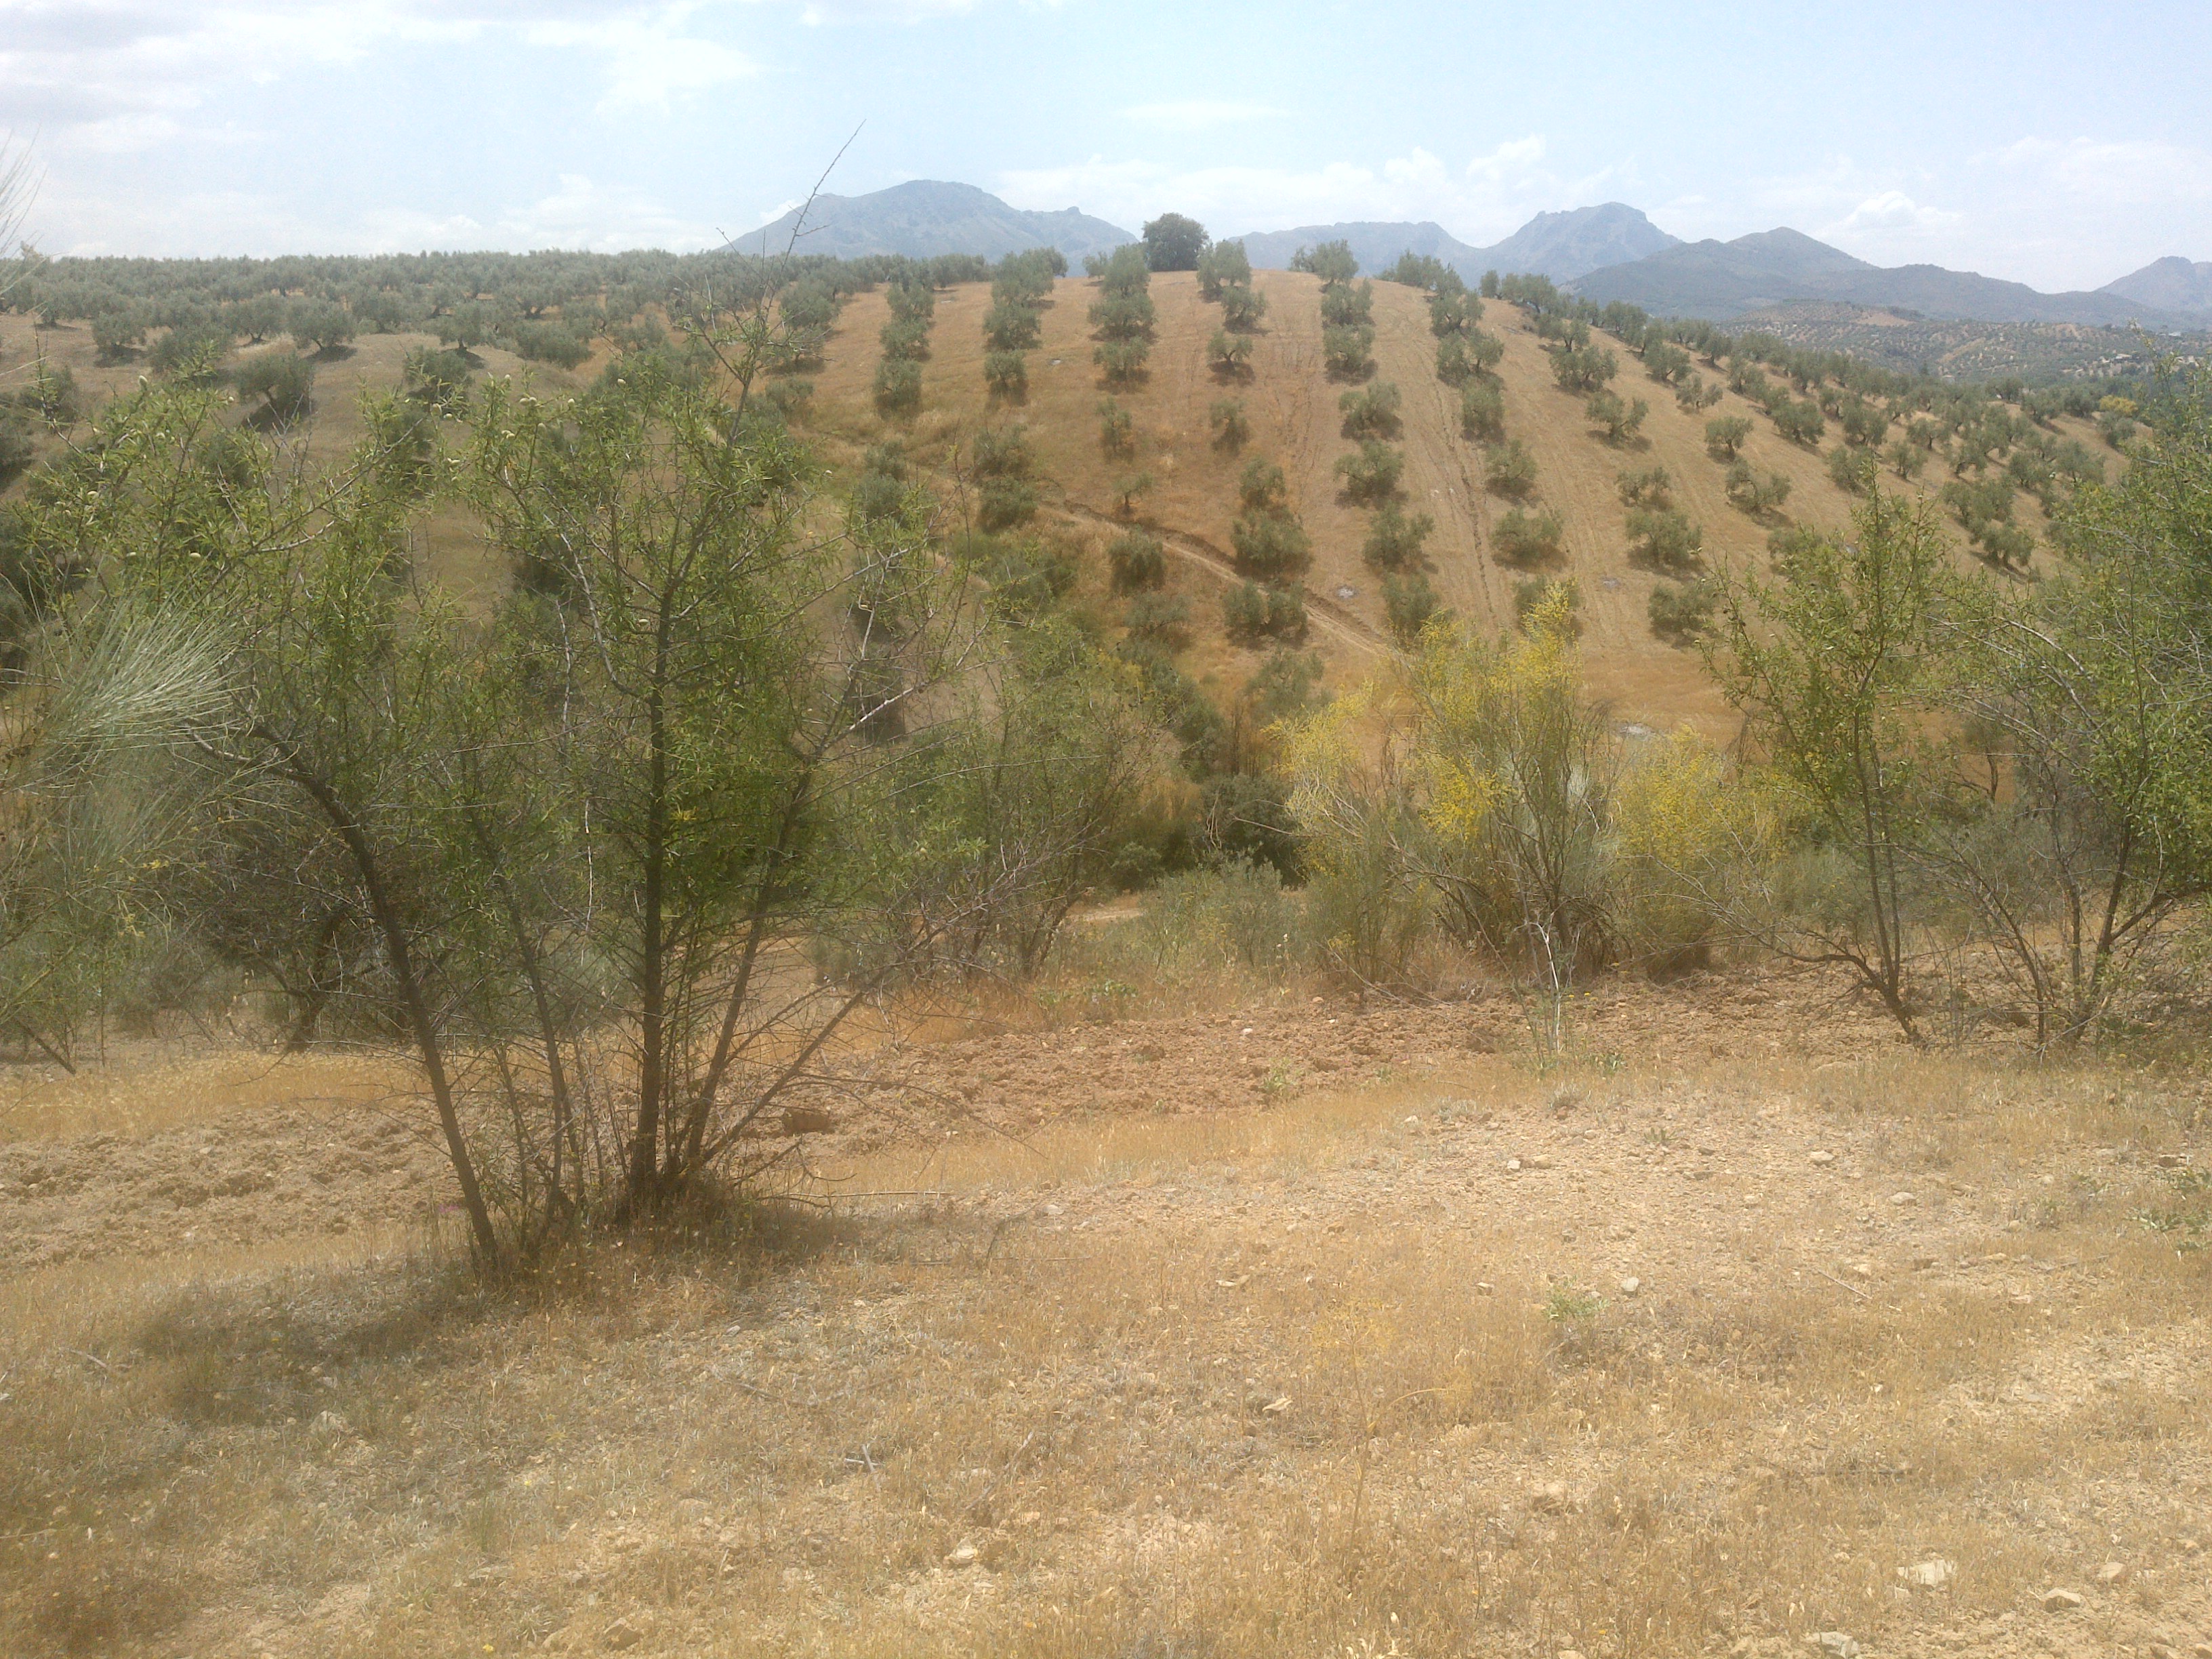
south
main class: Shrubland
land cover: Shrubland without tree cover
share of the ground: 25 - 50 %
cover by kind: herbaceous plants 50 %, shrubs 25 %, unconsolidated bare surface 25 %
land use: Semi-natural and natural areas not in use
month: May
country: ES
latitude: 37.4823
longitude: -4.2159
